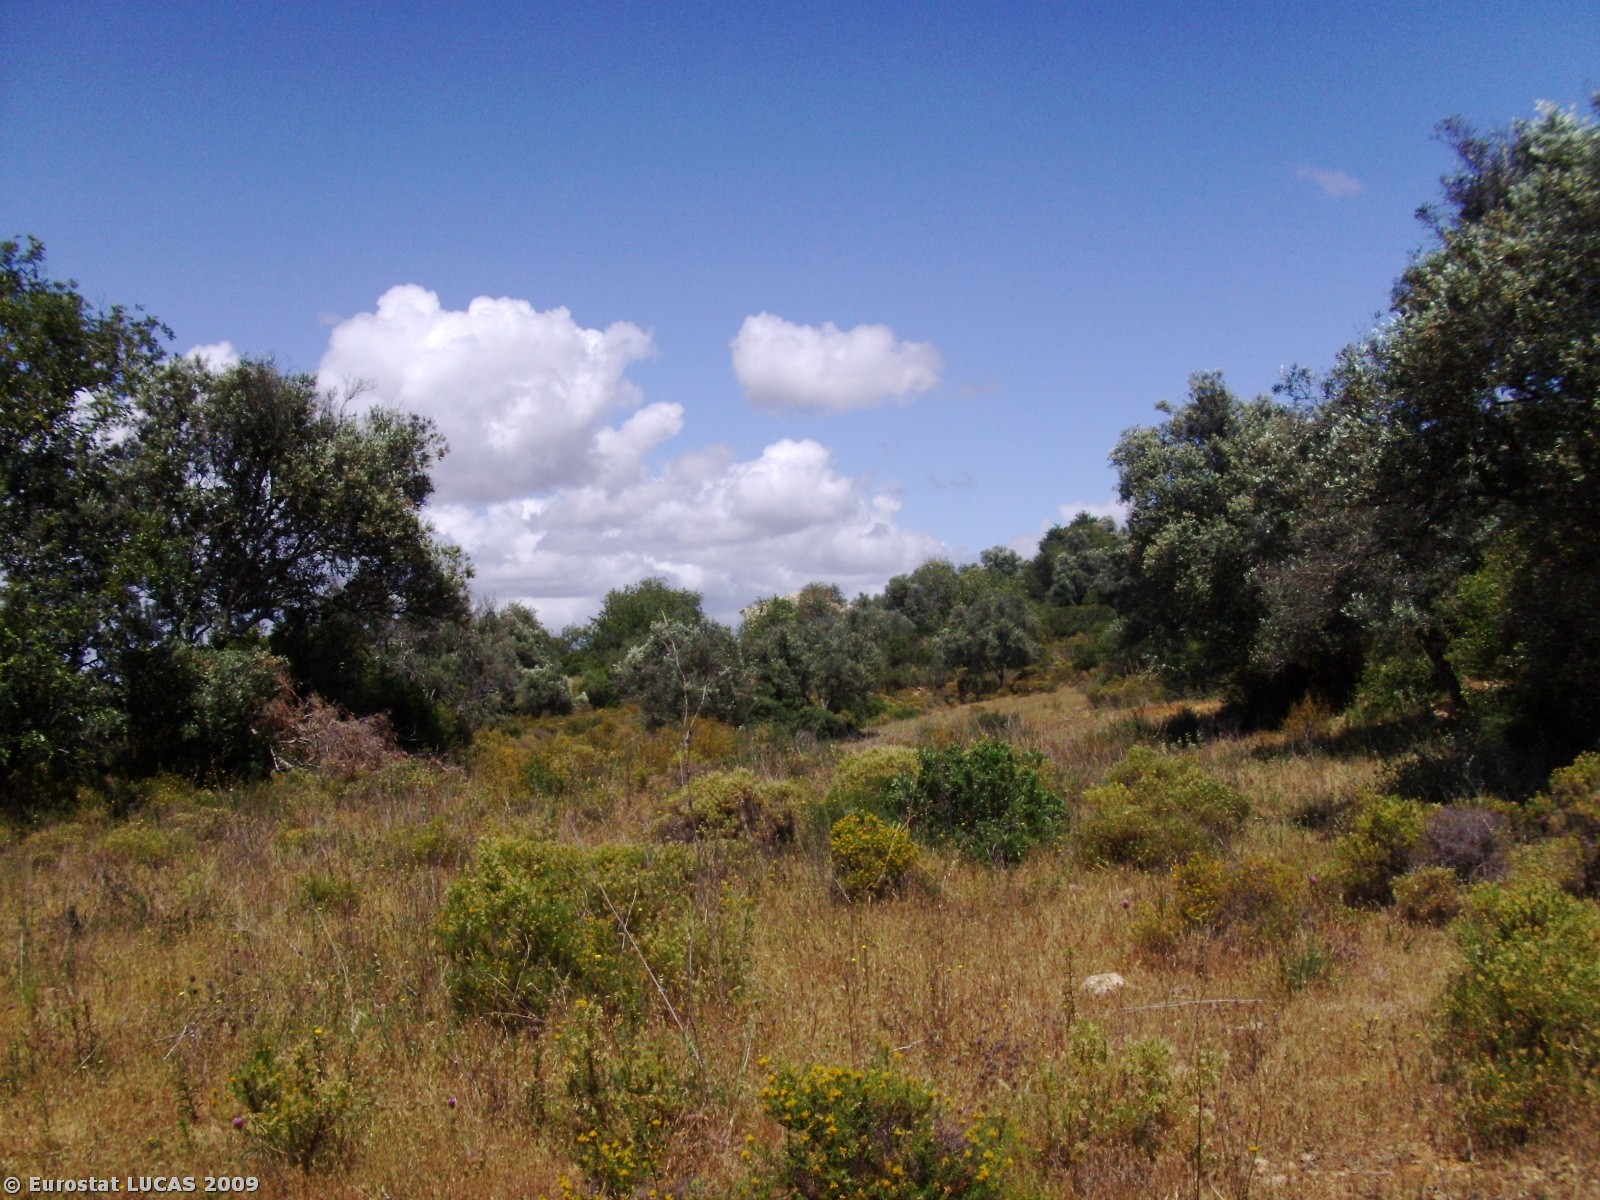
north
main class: Grassland
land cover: Grassland with sparse tree/shrub cover
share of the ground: > 75 %
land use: Fallow land
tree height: > 5 m
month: May
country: PT
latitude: 37.1432
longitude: -8.3839
